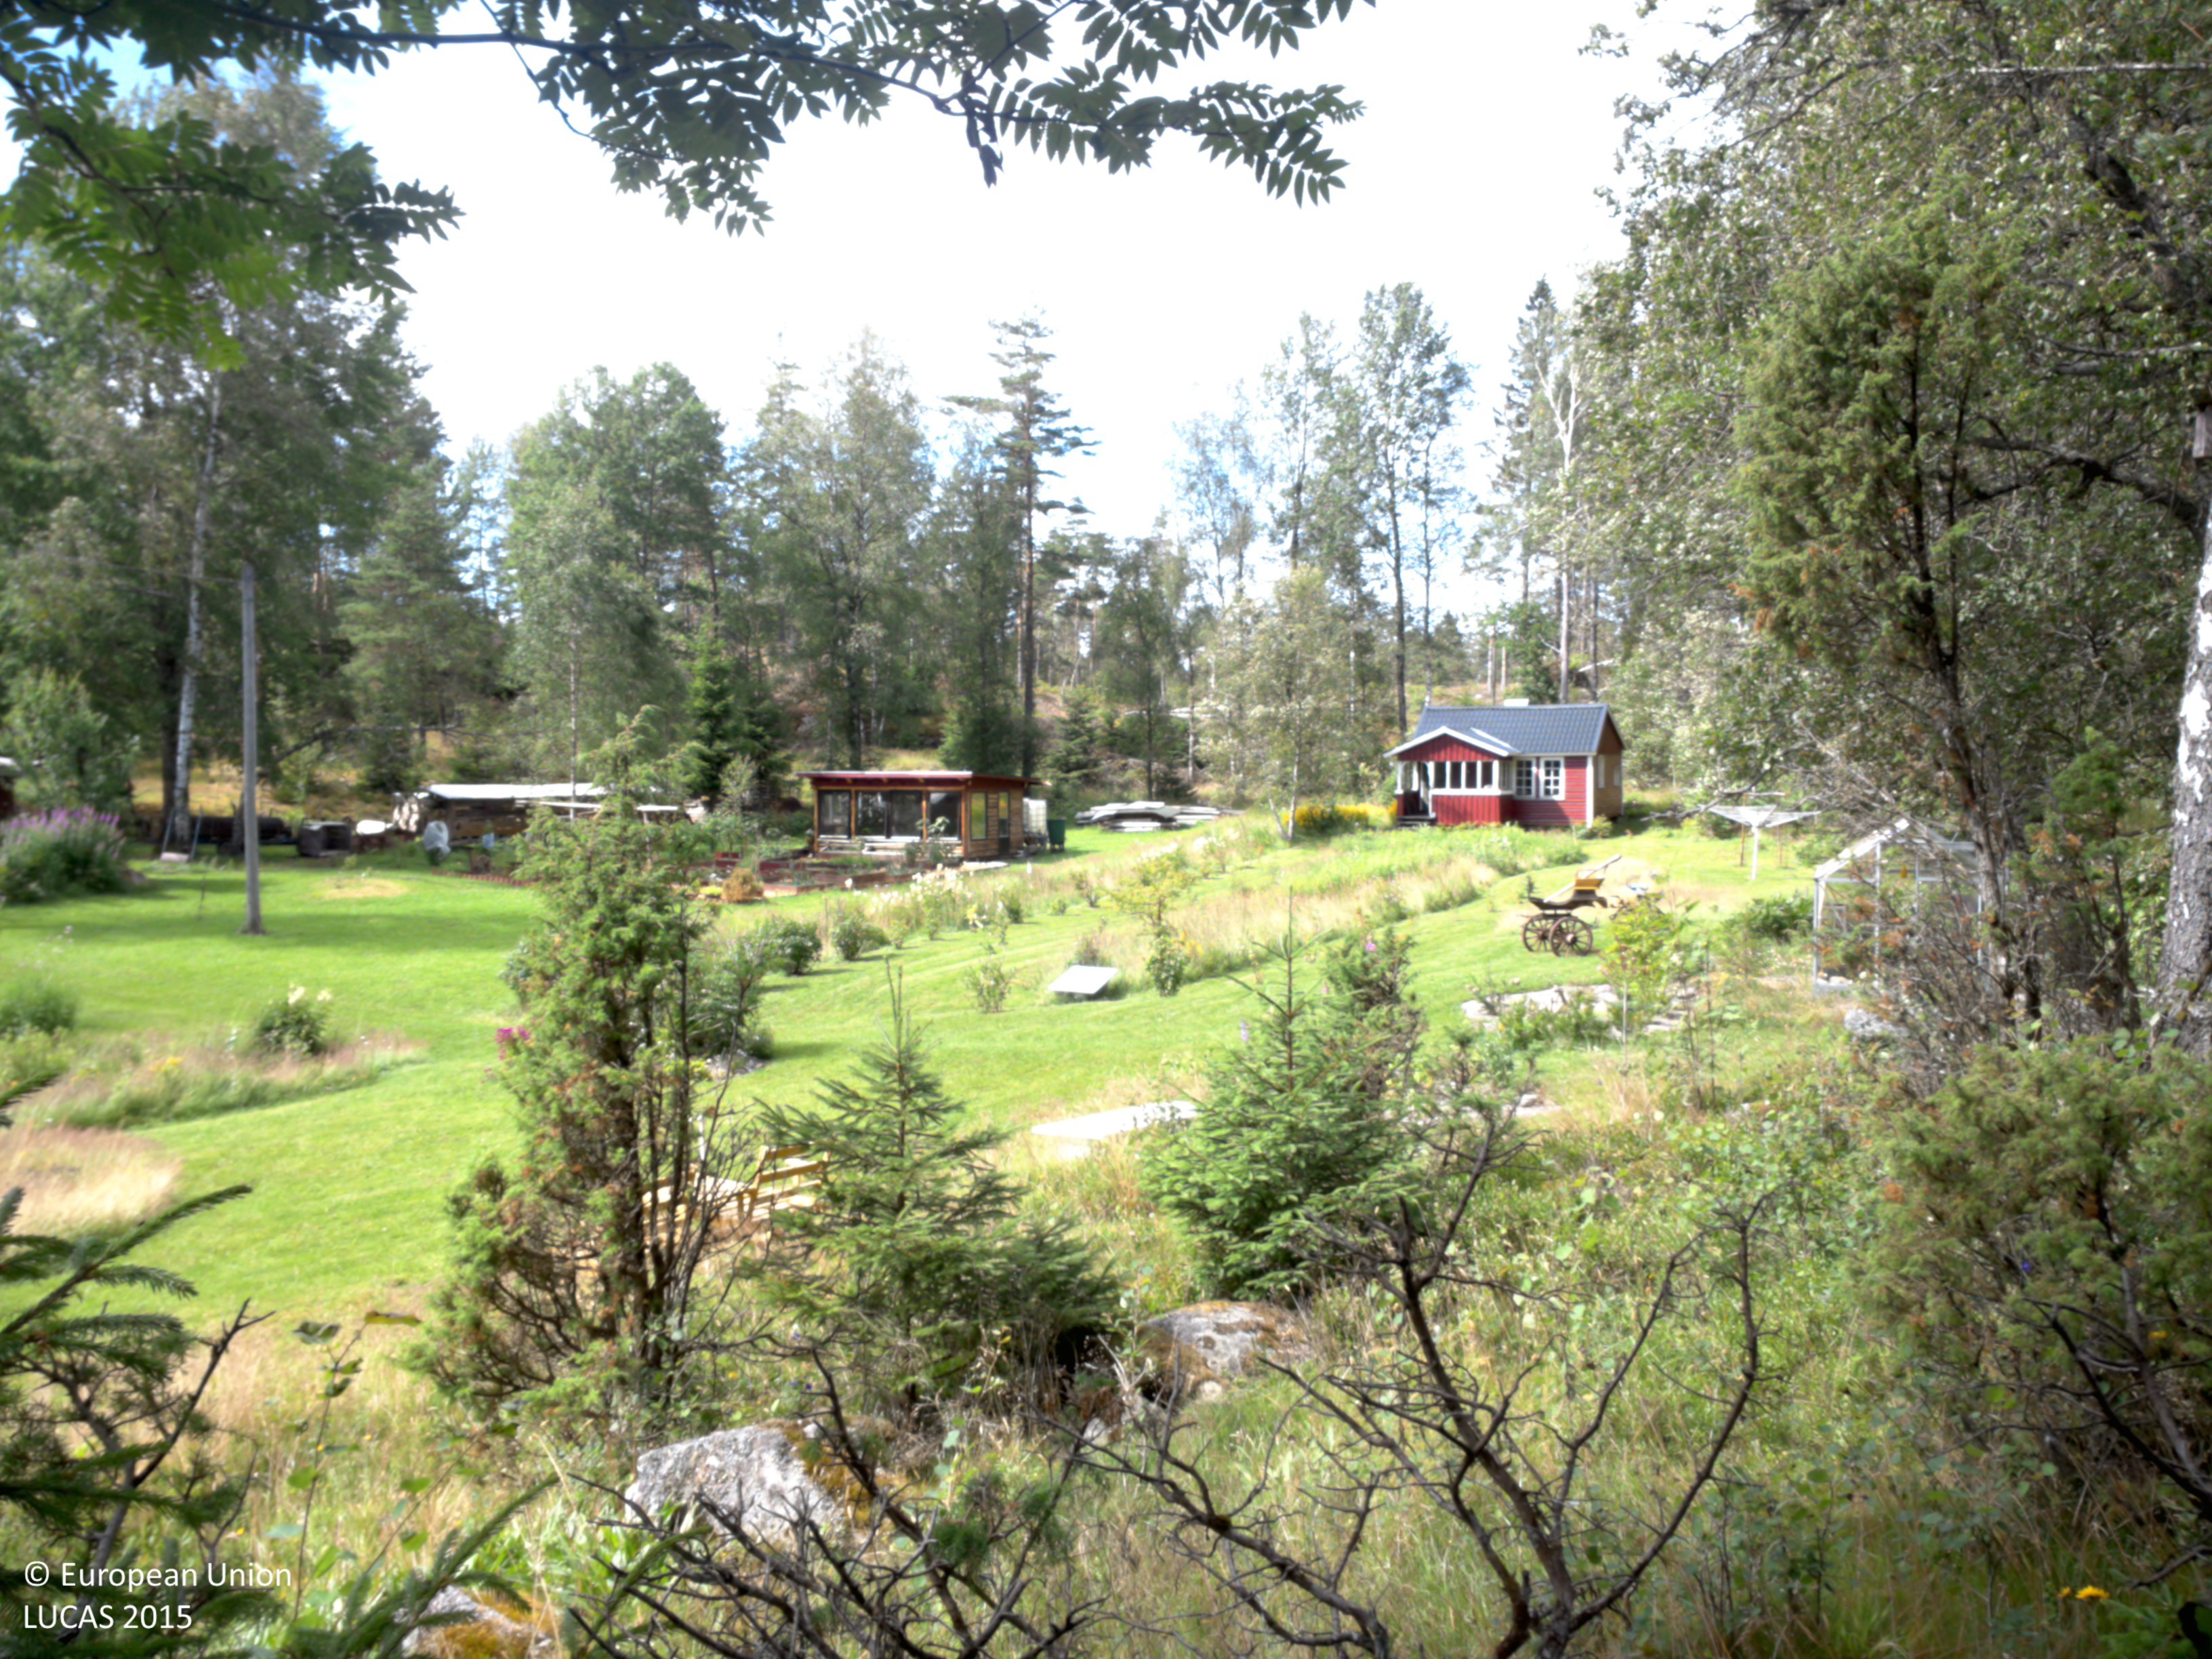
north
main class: Woodland
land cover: Spruce dominated mixed woodland
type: boreal forest
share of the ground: > 75 %
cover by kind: coniferous forest trees 60 %, broadleaved forest trees 20 %, herbaceous plants 10 %, lichens and mosses 10 %
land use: Forestry
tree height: > 5 m
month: July
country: SE
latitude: 58.5663
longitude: 11.8699
